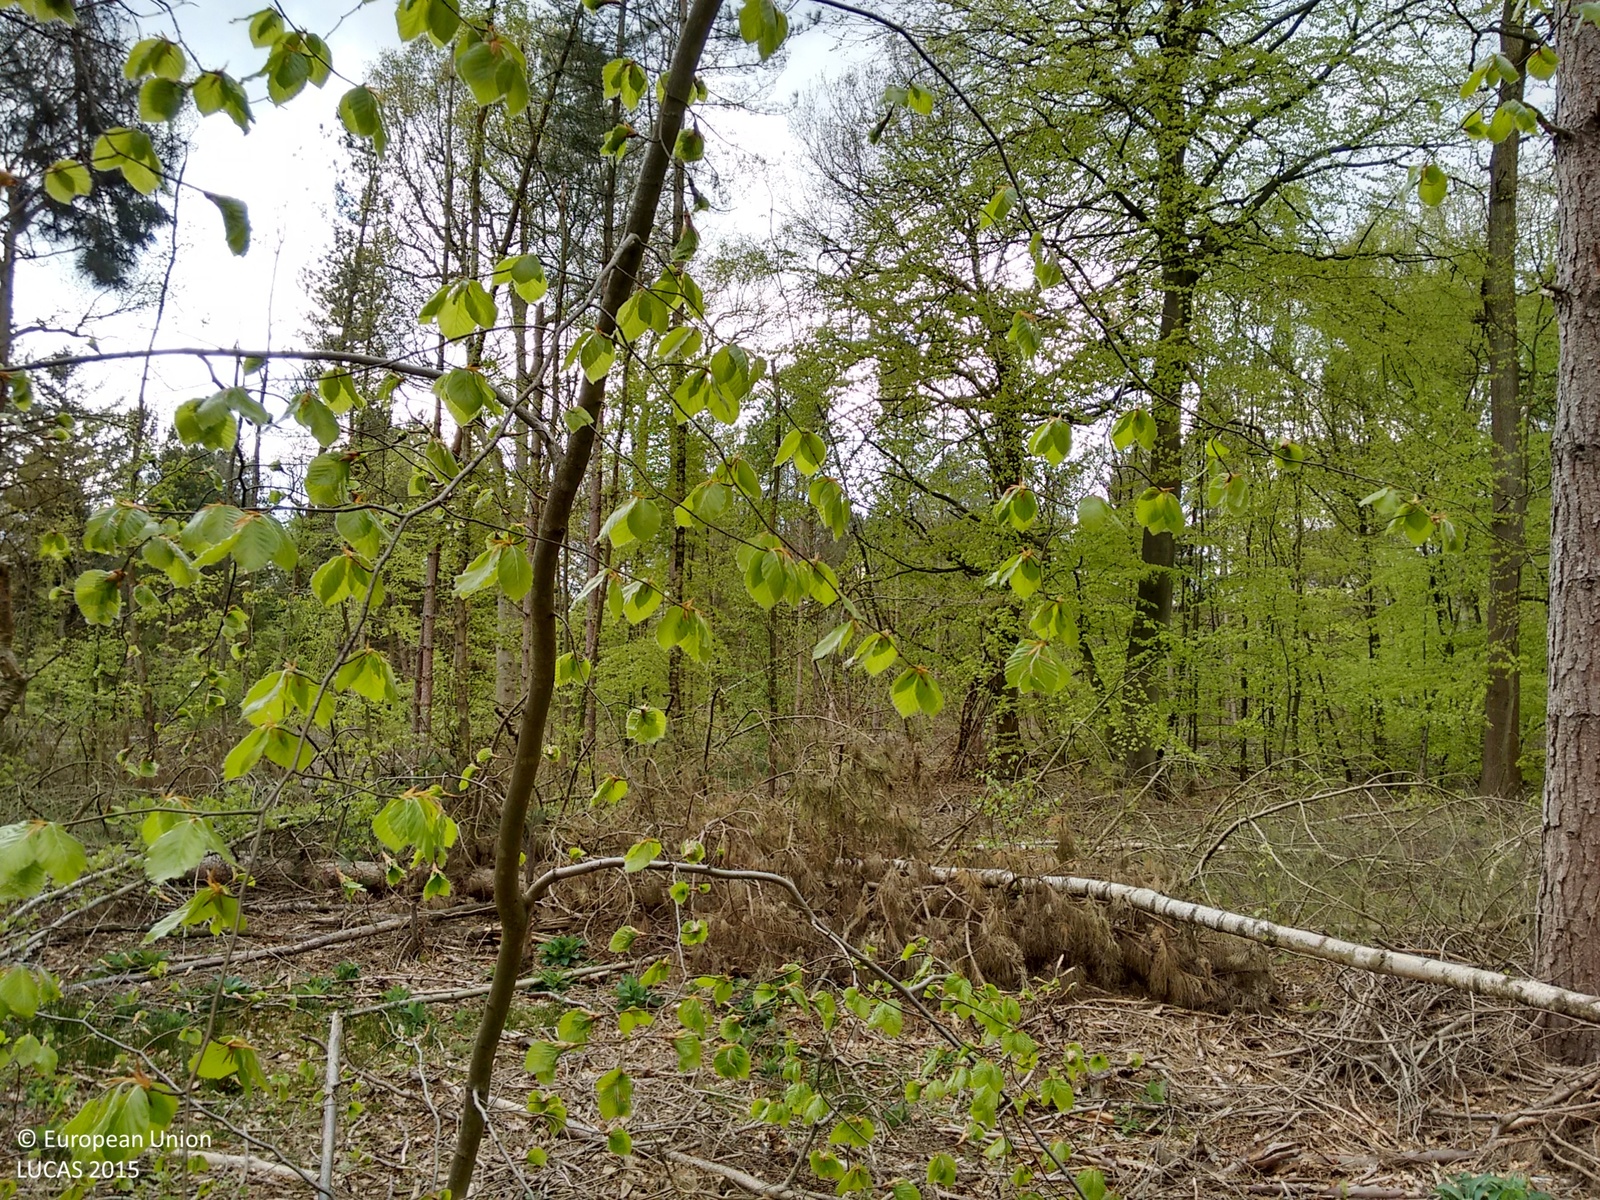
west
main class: Woodland
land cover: Pine dominated mixed woodland
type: mesophytic deciduous forest
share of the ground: 50 - 75 %
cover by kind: coniferous forest trees 60 %, broadleaved forest trees 30 %, shrubs 10 %
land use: Forestry
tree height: > 5 m
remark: Clear cut
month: April
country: GB
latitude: 51.6597
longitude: -0.6656
